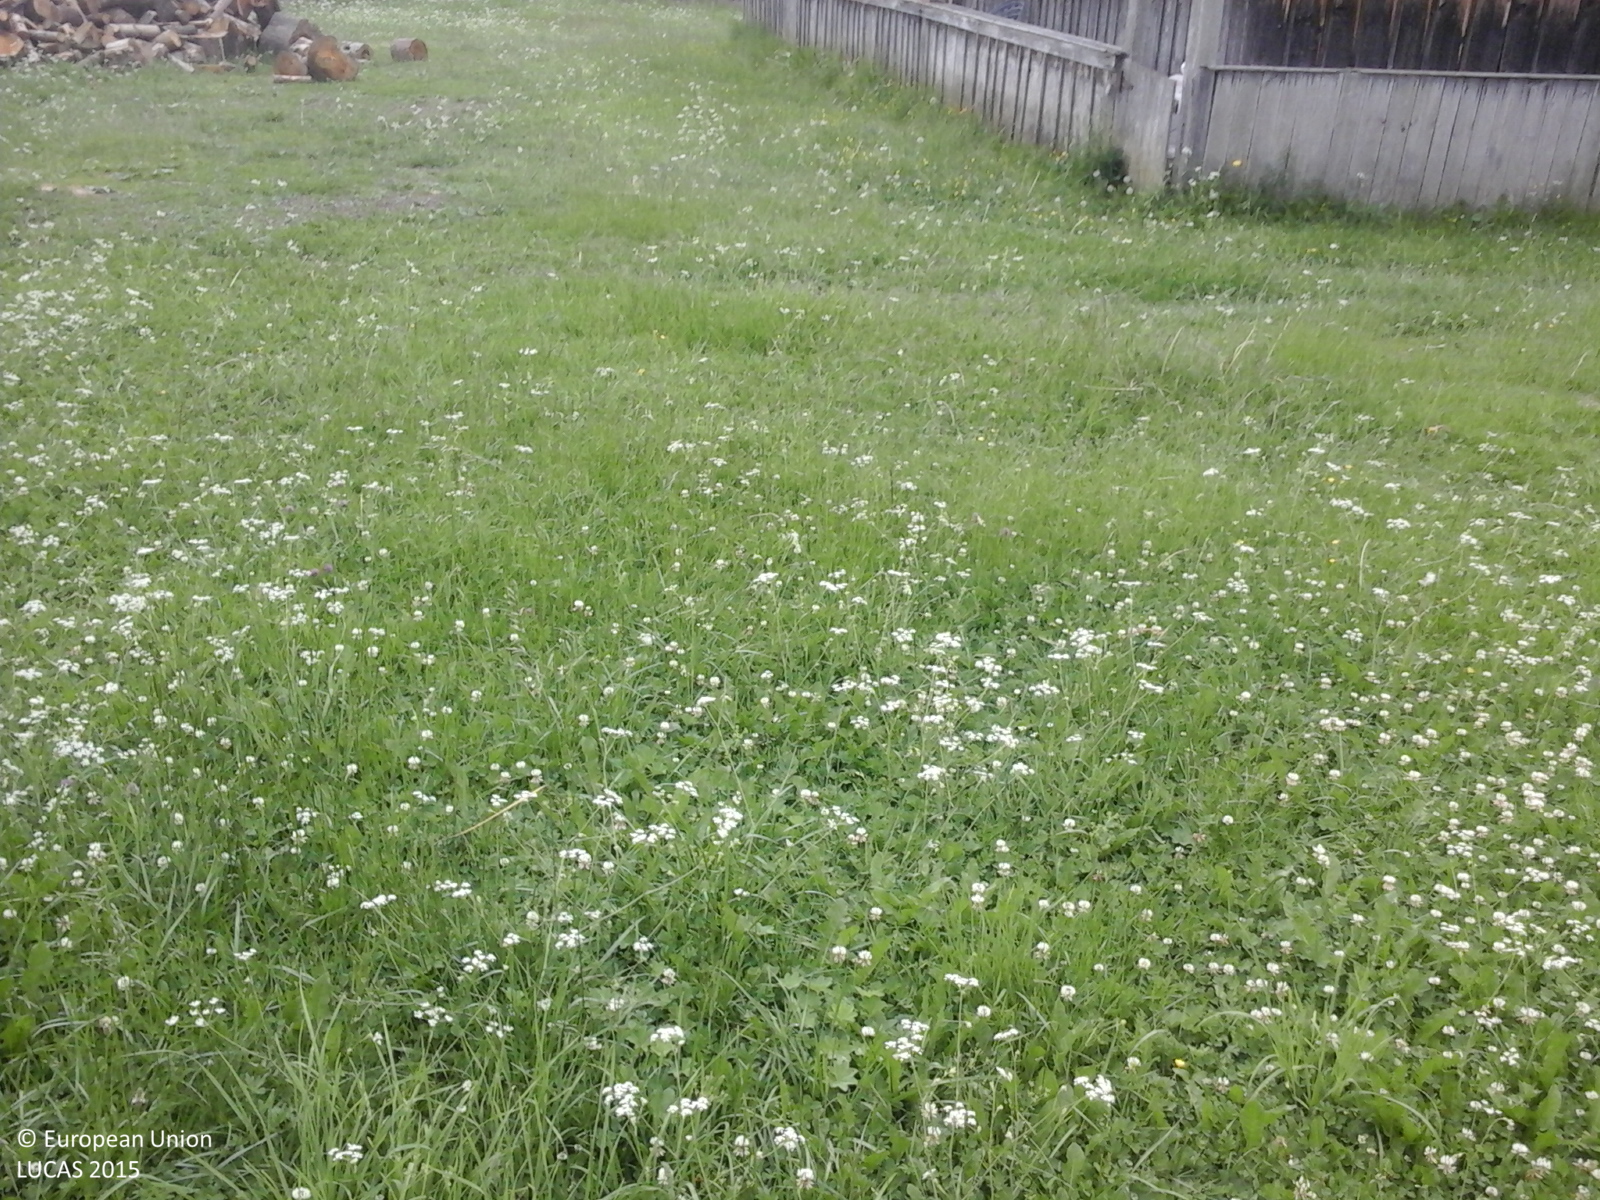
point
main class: Grassland
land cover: Grassland without tree/shrub cover
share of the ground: > 75 %
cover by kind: herbaceous plants 100 %
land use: Agriculture (excluding fallow land and kitchen gardens)
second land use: Residential
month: June
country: RO
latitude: 47.3366
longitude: 25.1271
